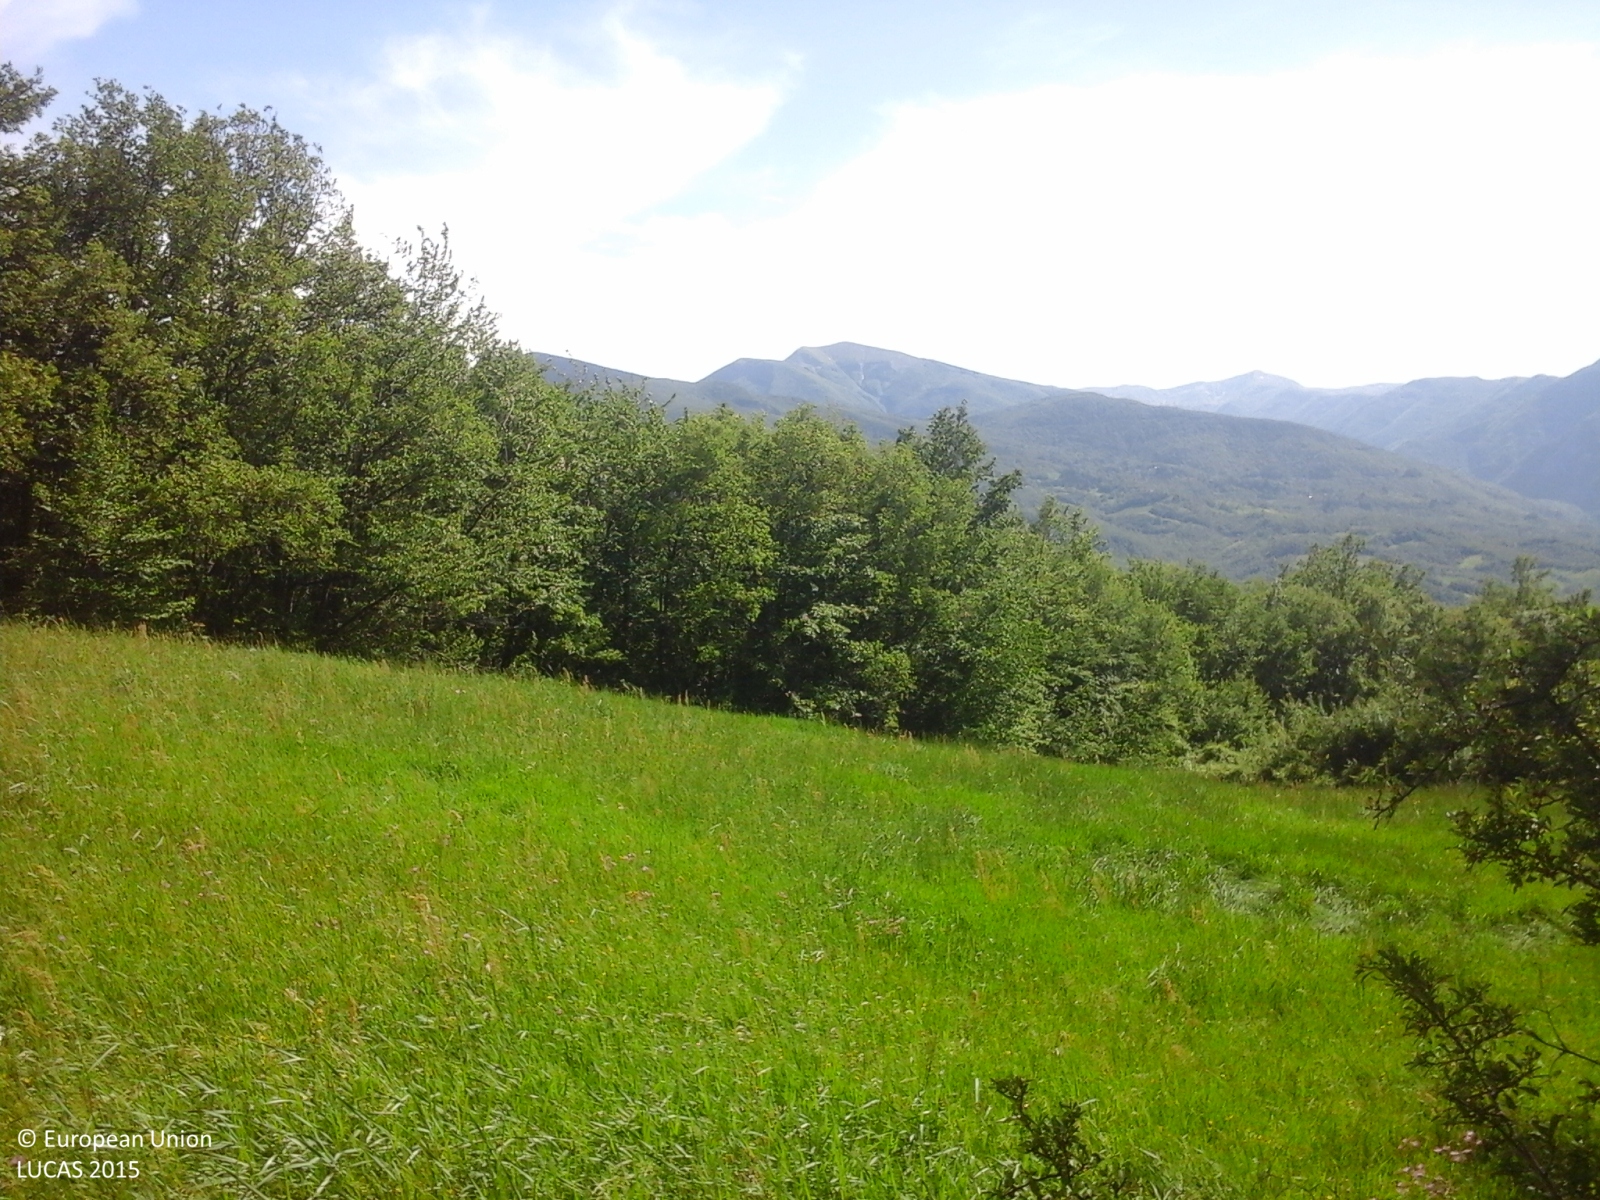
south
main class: Woodland
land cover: Broadleaved woodland
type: thermophilous deciduous forest
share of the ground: > 75 %
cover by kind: broadleaved forest trees 90 %, shrubs 10 %
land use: Forestry
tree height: > 5 m
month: May
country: IT
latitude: 44.2025
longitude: 10.8863
